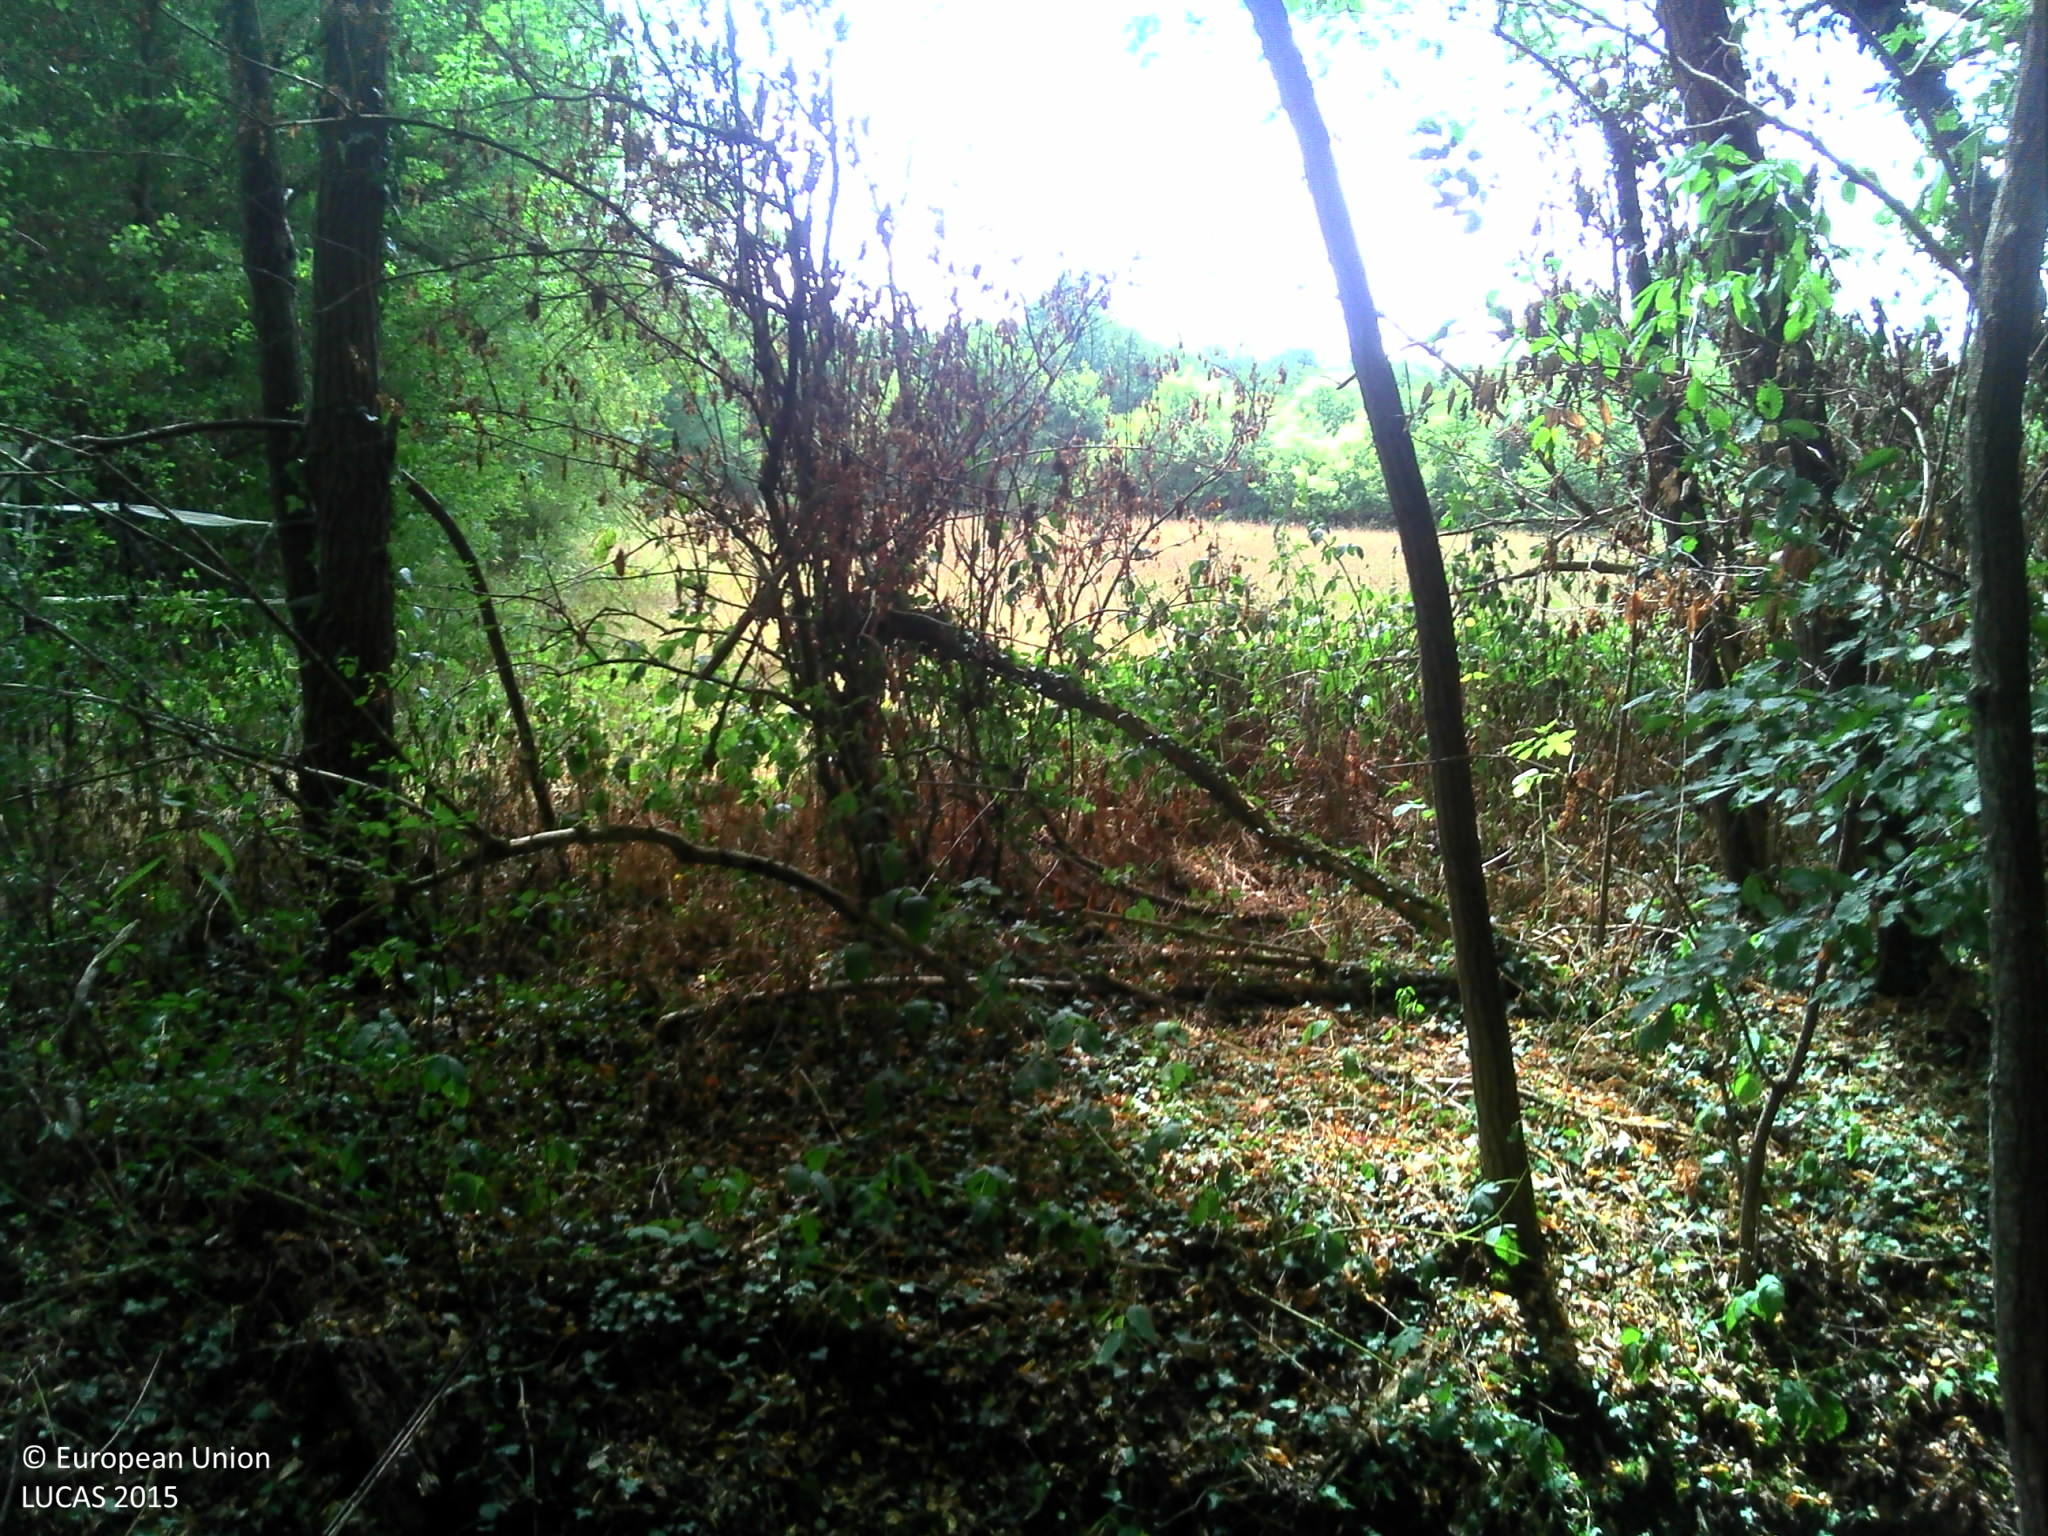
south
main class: Woodland
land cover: Broadleaved woodland
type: mesophytic deciduous forest
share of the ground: > 75 %
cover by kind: broadleaved forest trees 100 %
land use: Forestry
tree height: > 5 m
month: July
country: FR
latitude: 47.8768
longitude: 2.4897
